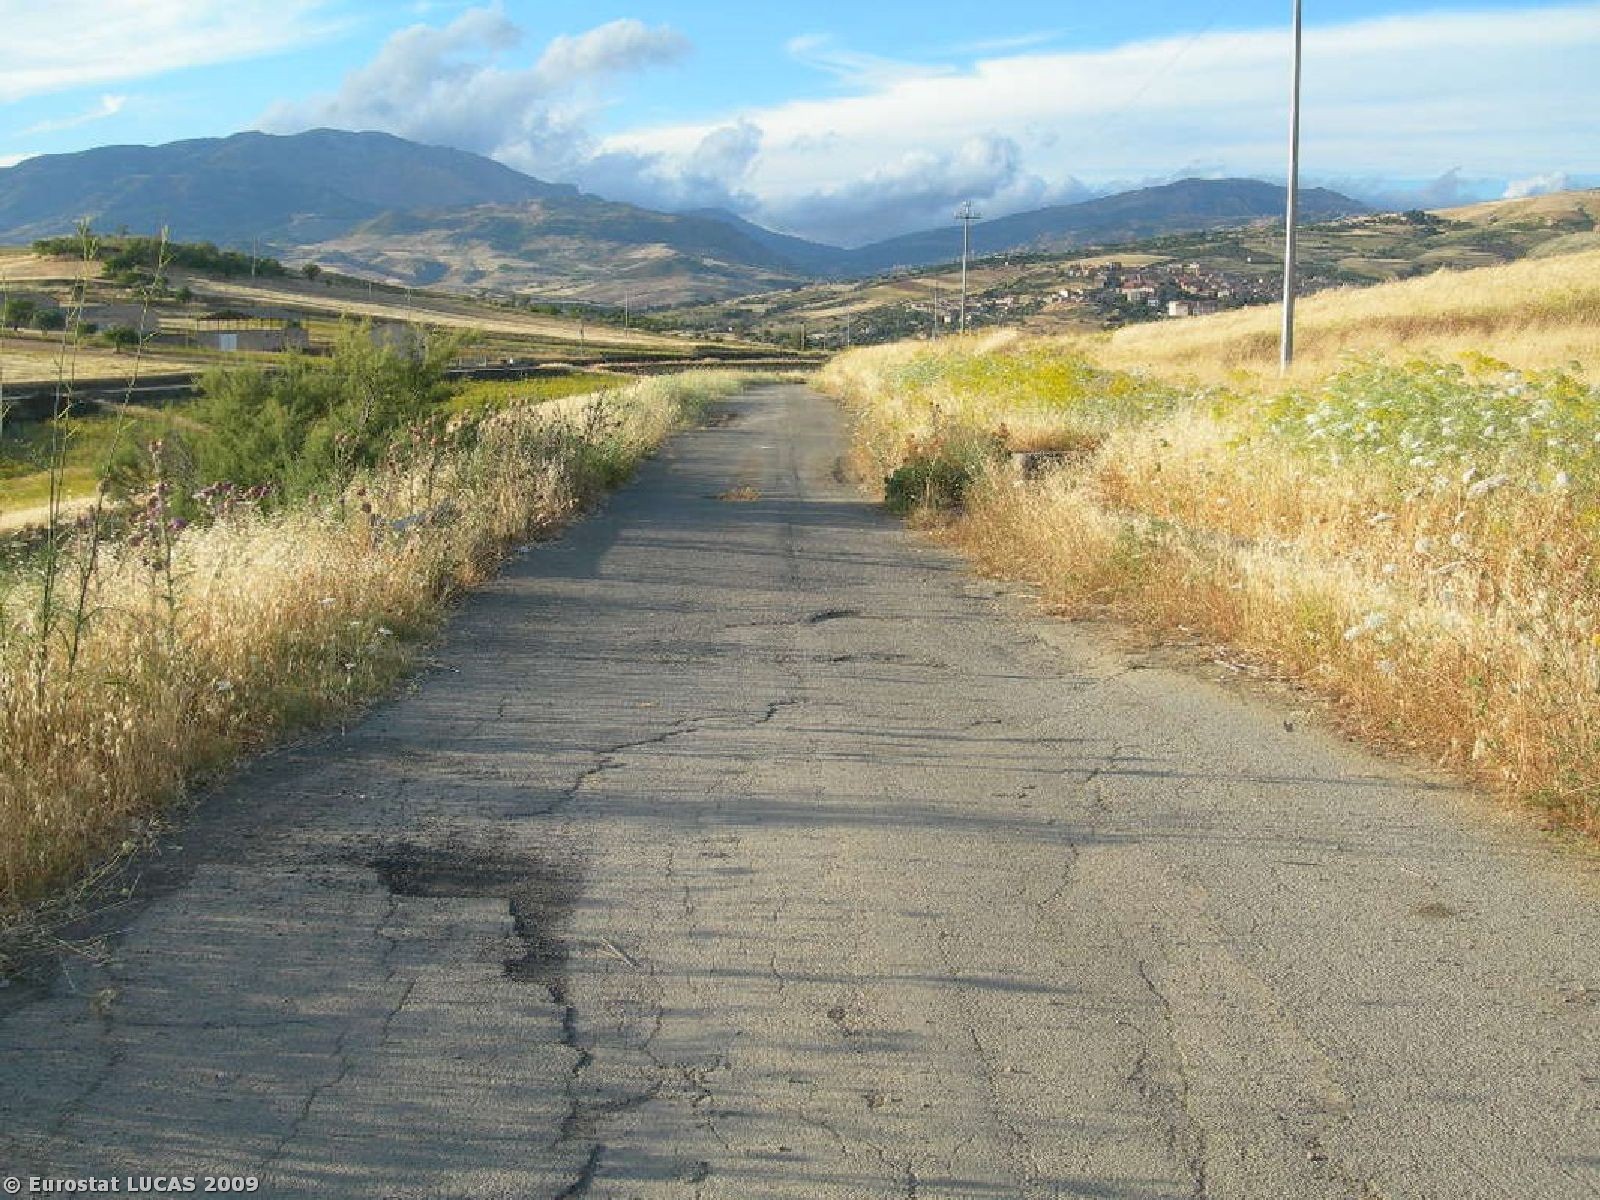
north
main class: Grassland
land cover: Spontaneously vegetated surfaces
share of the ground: > 75 %
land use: Fallow land
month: June
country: IT
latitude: 37.7332
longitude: 14.0669
